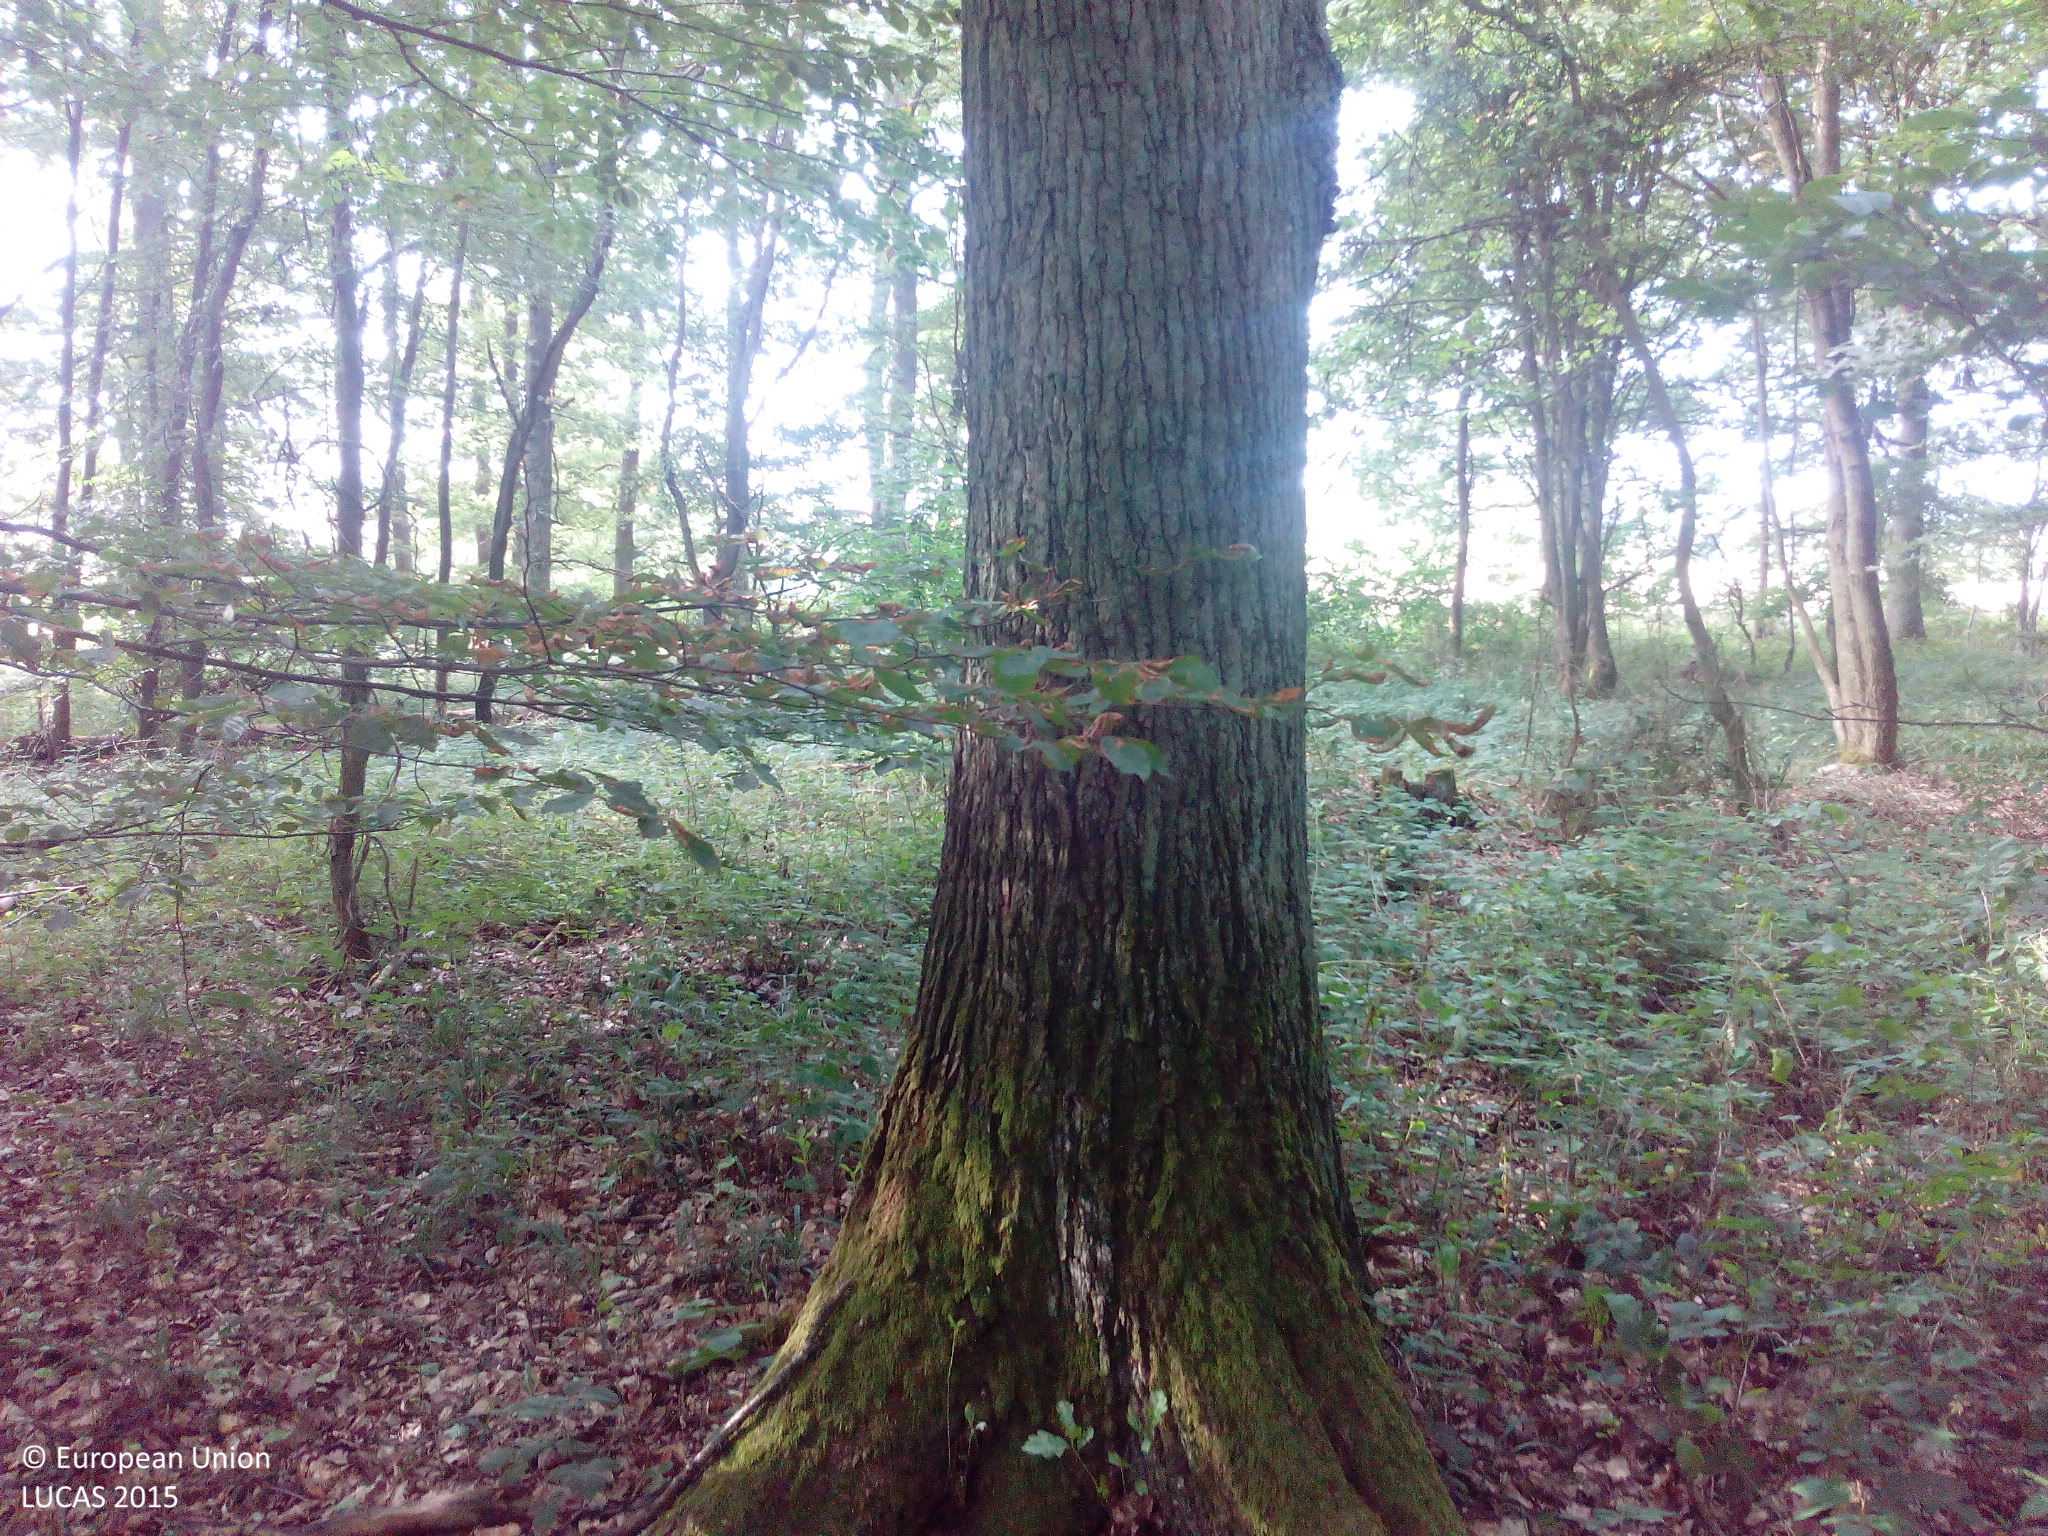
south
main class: Woodland
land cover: Broadleaved woodland
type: beech forest
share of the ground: > 75 %
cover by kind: broadleaved forest trees 75 %, coniferous forest trees 15 %, herbaceous plants 5 %, unconsolidated bare surface 5 %
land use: Forestry
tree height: > 5 m
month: July
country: DE
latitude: 49.8518
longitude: 7.5386
